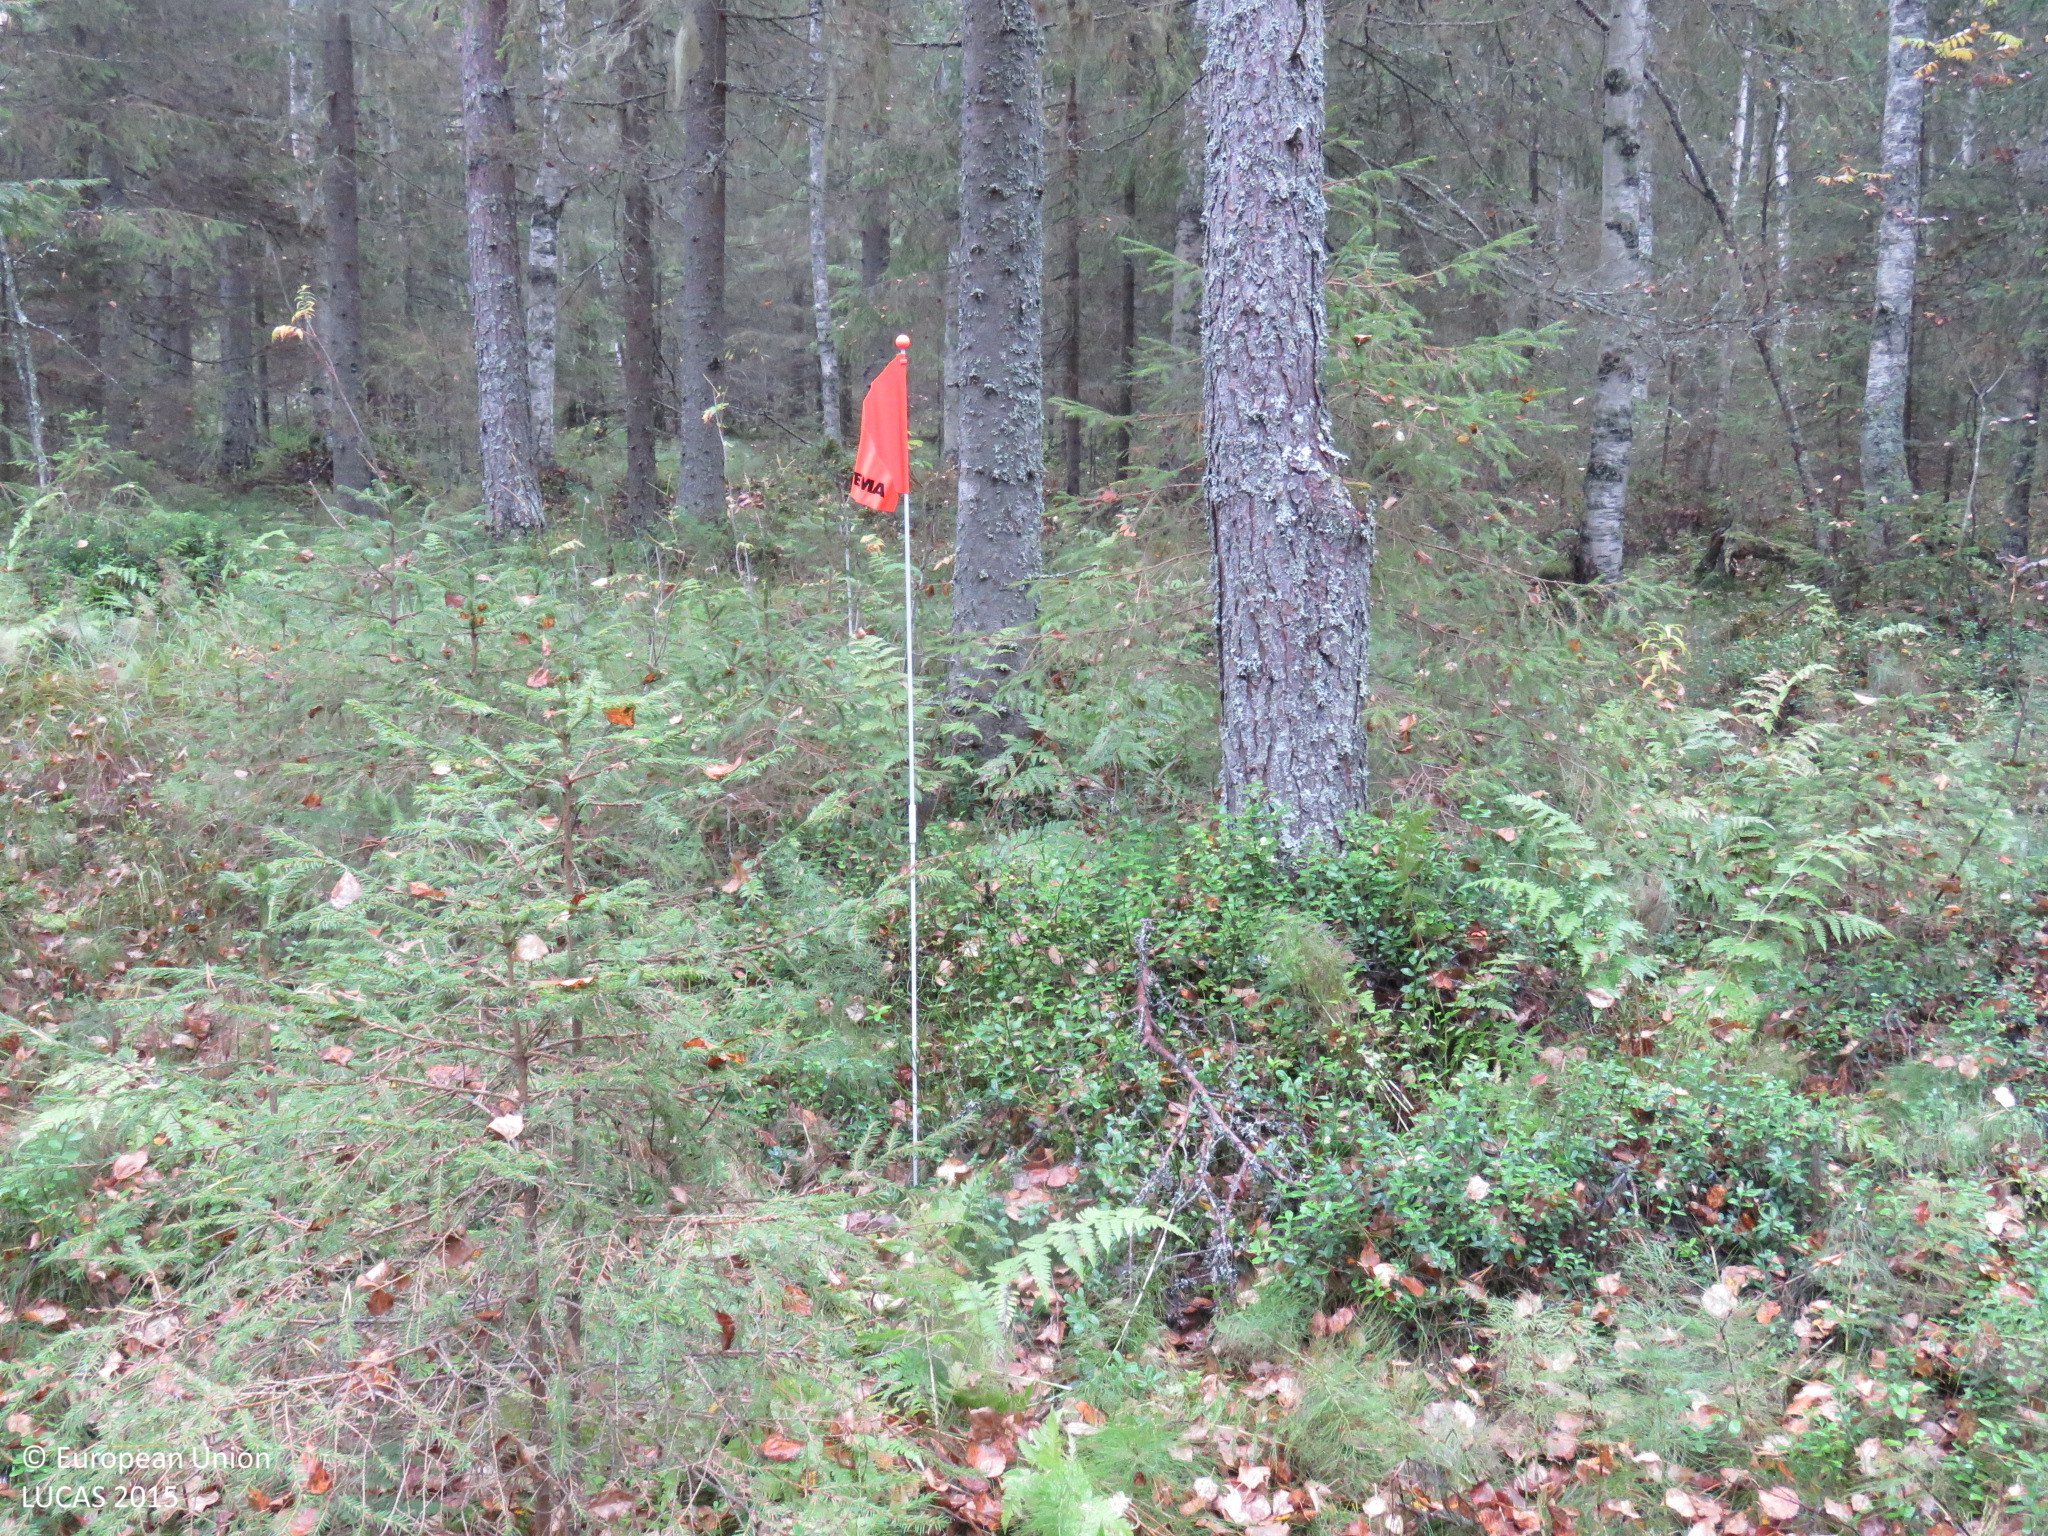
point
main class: Woodland
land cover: Other mixed woodland
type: boreal forest
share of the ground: > 75 %
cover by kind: coniferous forest trees 65 %, broadleaved forest trees 25 %, shrubs 5 %, herbaceous plants 5 %
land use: Forestry
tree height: > 5 m
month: September
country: FI
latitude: 64.8785
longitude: 26.6867
